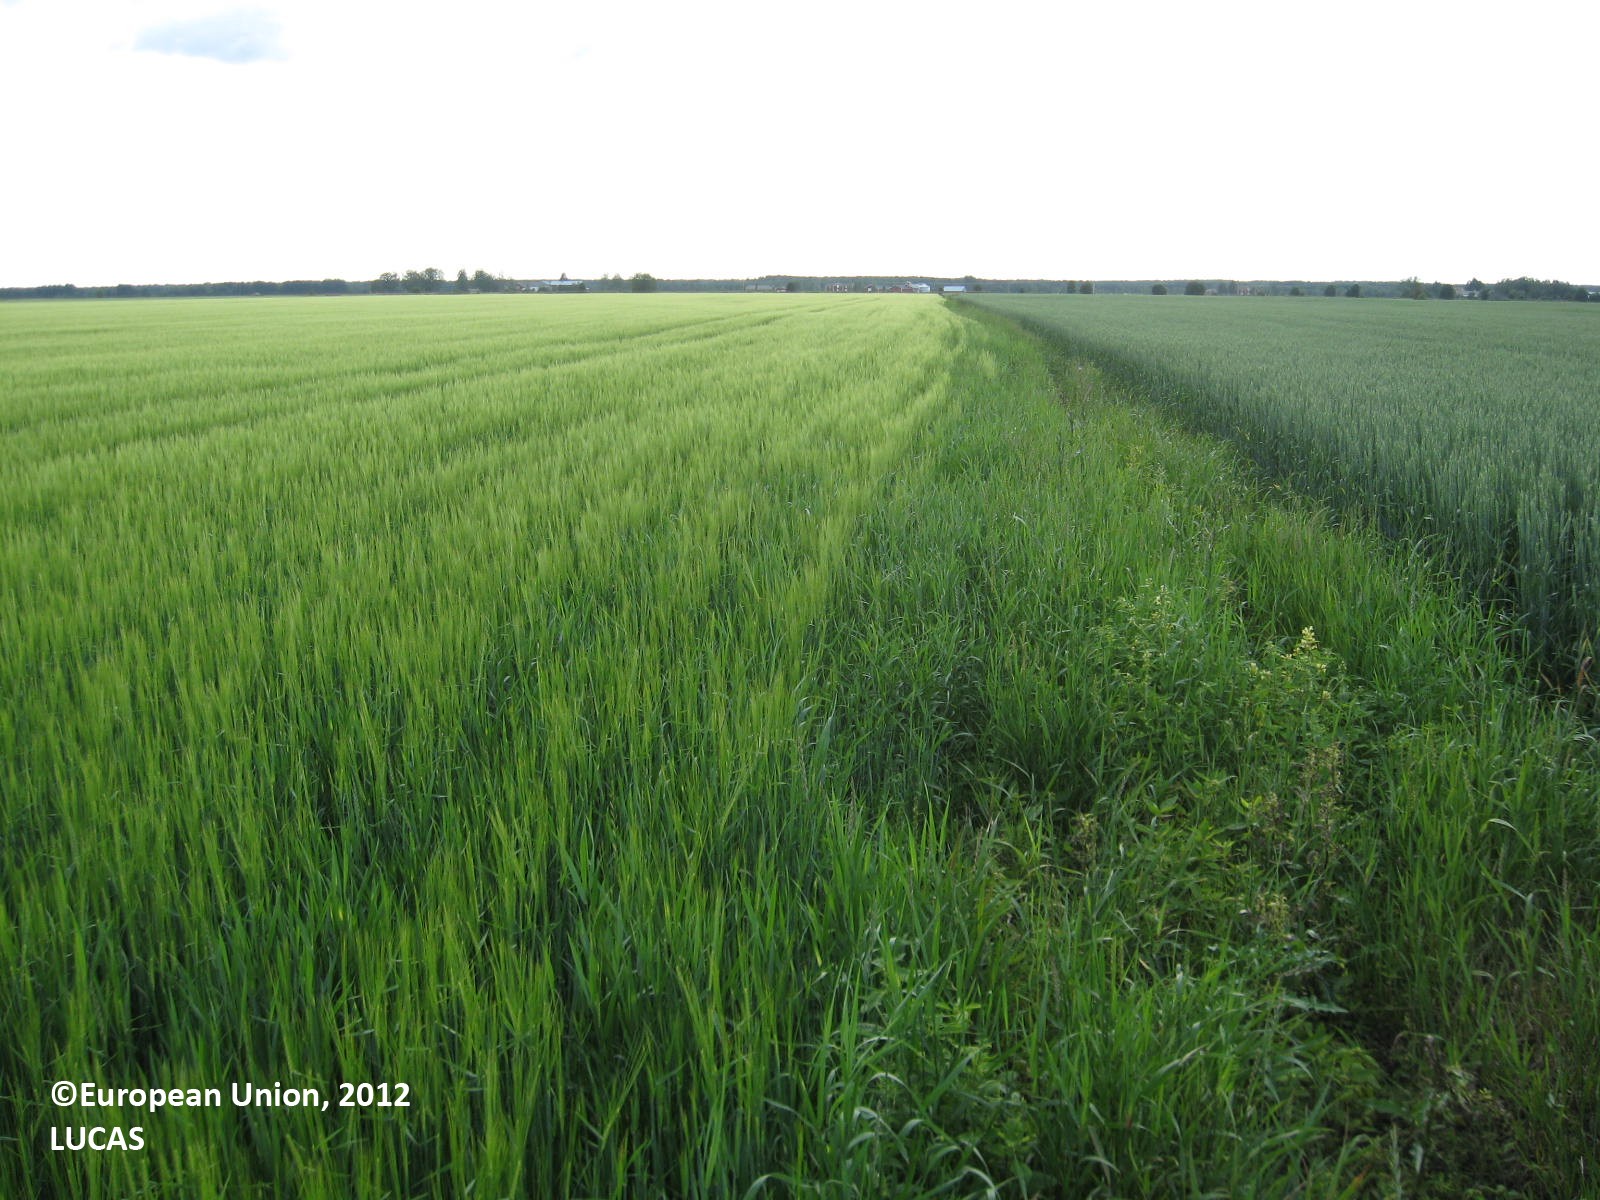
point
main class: Cropland
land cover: Barley
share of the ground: > 75 %
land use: Agriculture (excluding fallow land and kitchen gardens)
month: July
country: FI
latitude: 62.5745
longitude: 21.4661
